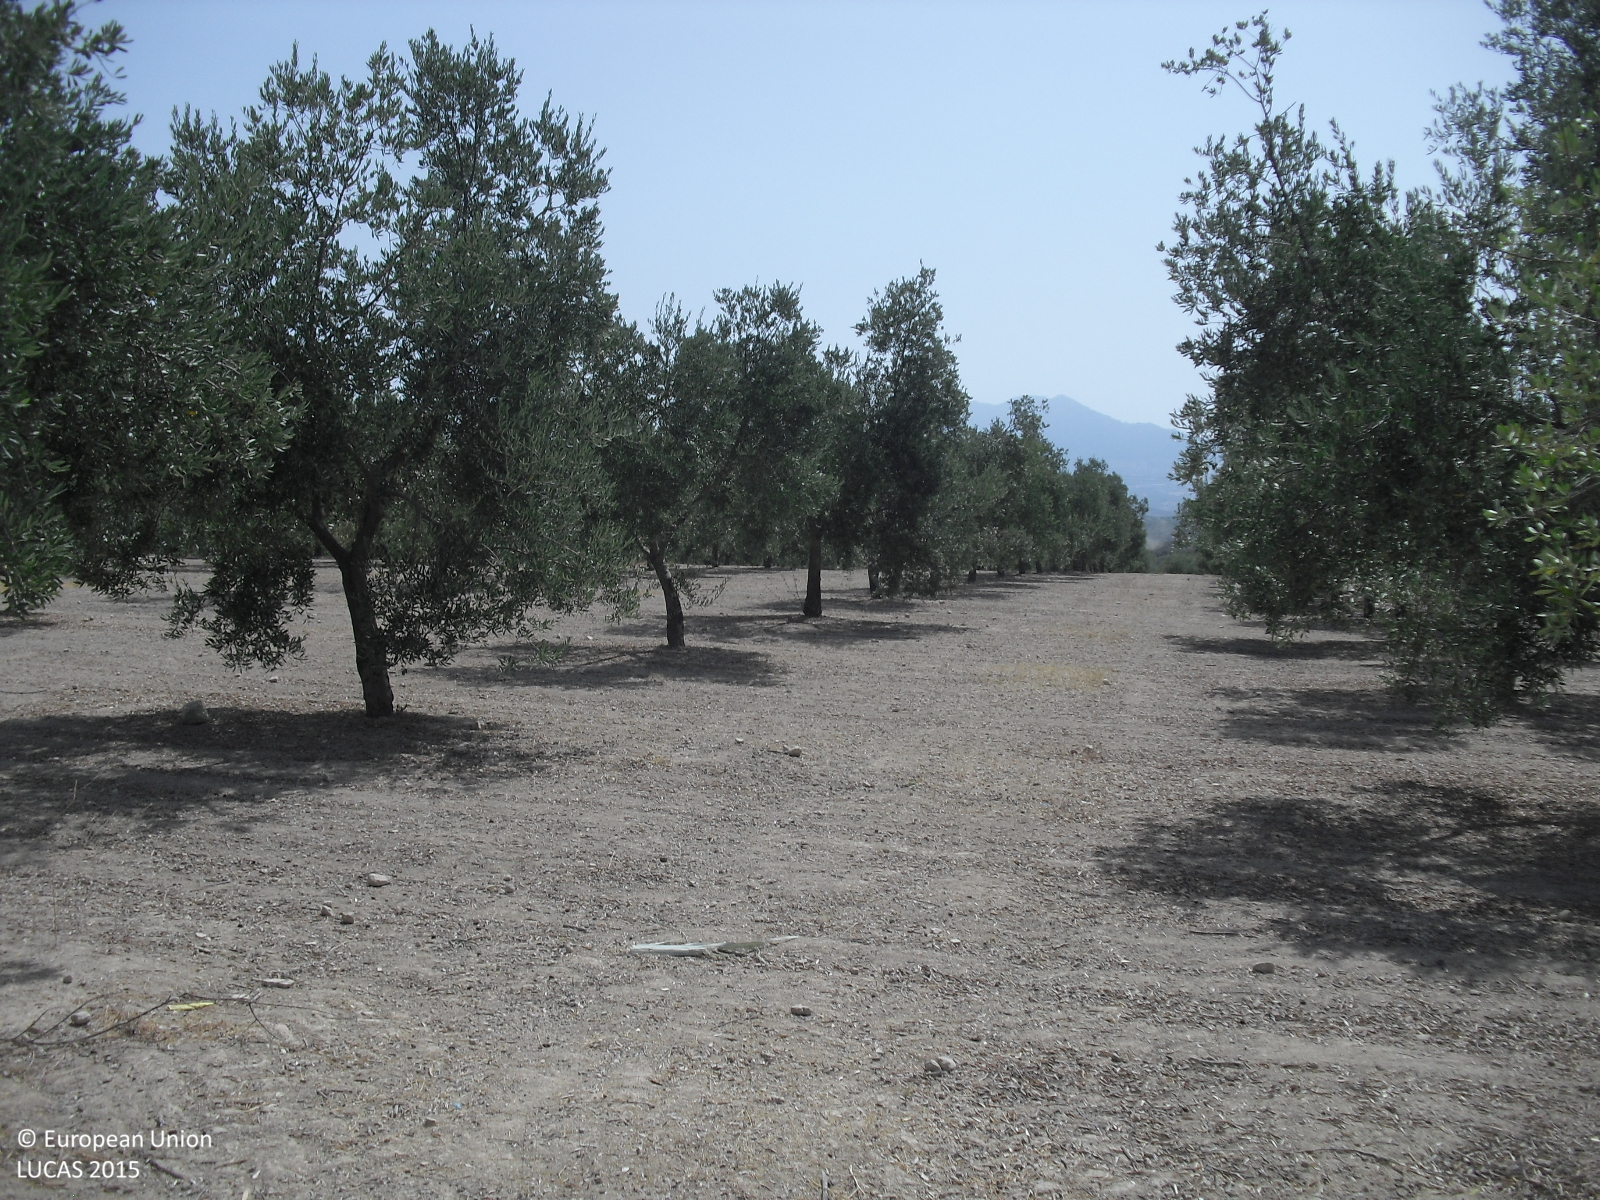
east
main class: Cropland
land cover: Olive groves
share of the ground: 25 - 50 %
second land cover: Other bare soil
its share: > 75 %
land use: Agriculture (excluding fallow land and kitchen gardens)
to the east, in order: Olive groves; Other bare soil; Tracks; Olive groves; Electric lines; Olive groves
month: August
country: ES
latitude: 37.3527
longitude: -4.4631
